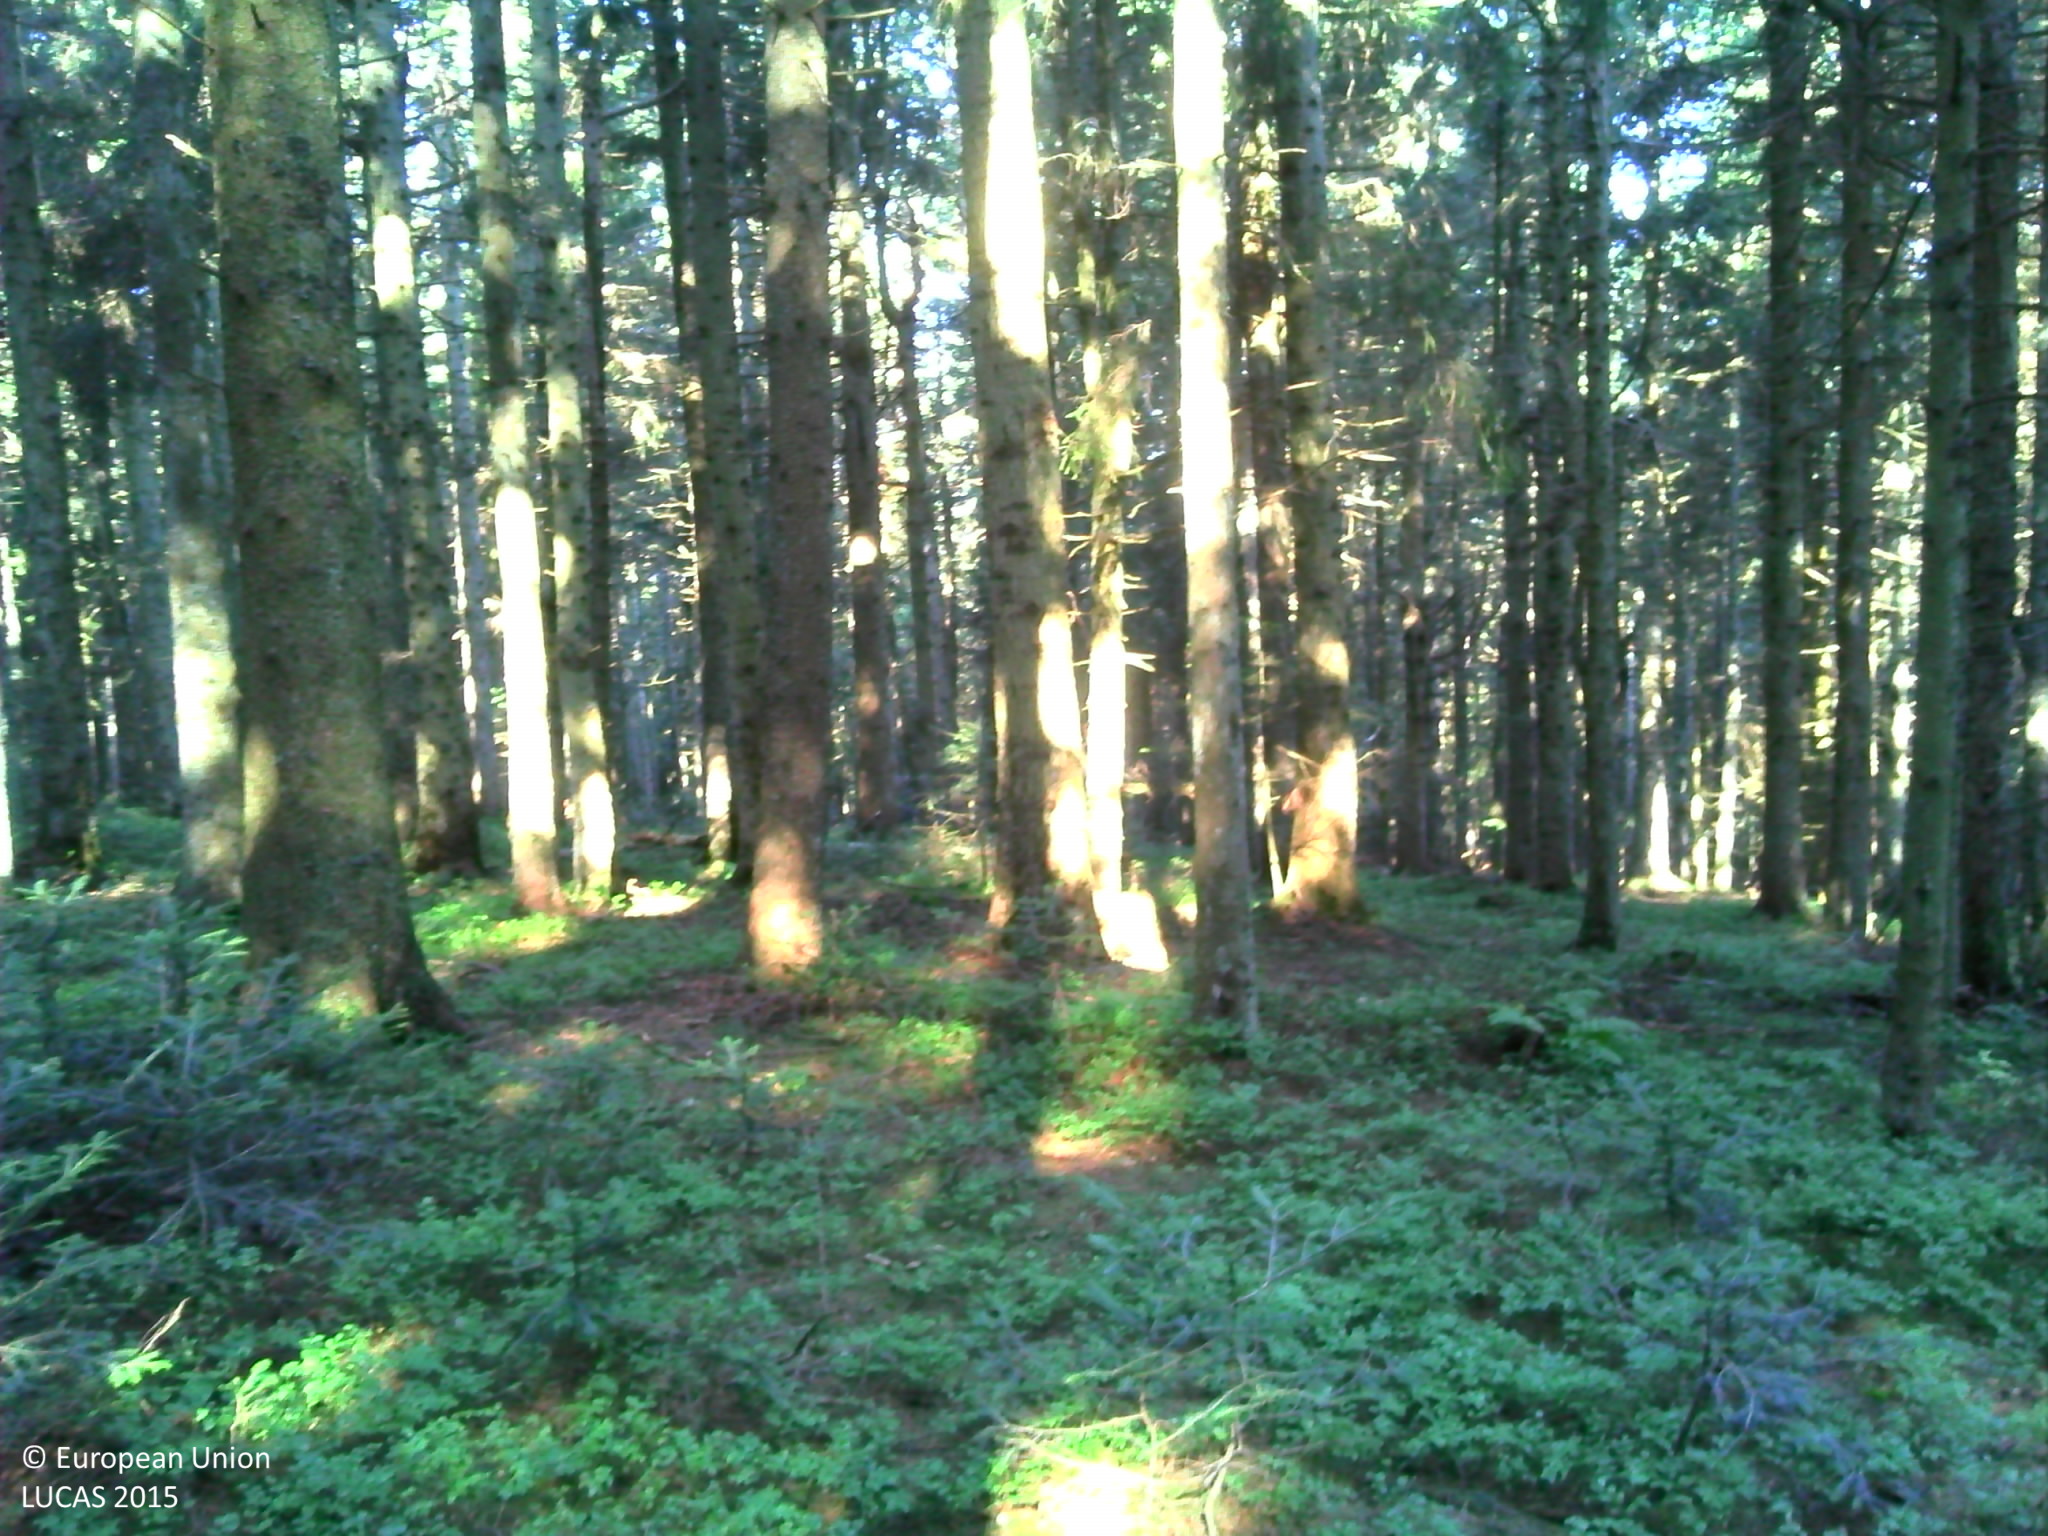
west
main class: Woodland
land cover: Spruce dominated coniferous woodland
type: alpine coniferous forest
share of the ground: > 75 %
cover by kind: coniferous forest trees 65 %, herbaceous plants 20 %, lichens and mosses 10 %, shrubs 5 %
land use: Forestry
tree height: > 5 m
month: August
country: FR
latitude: 45.3625
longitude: 4.5273
